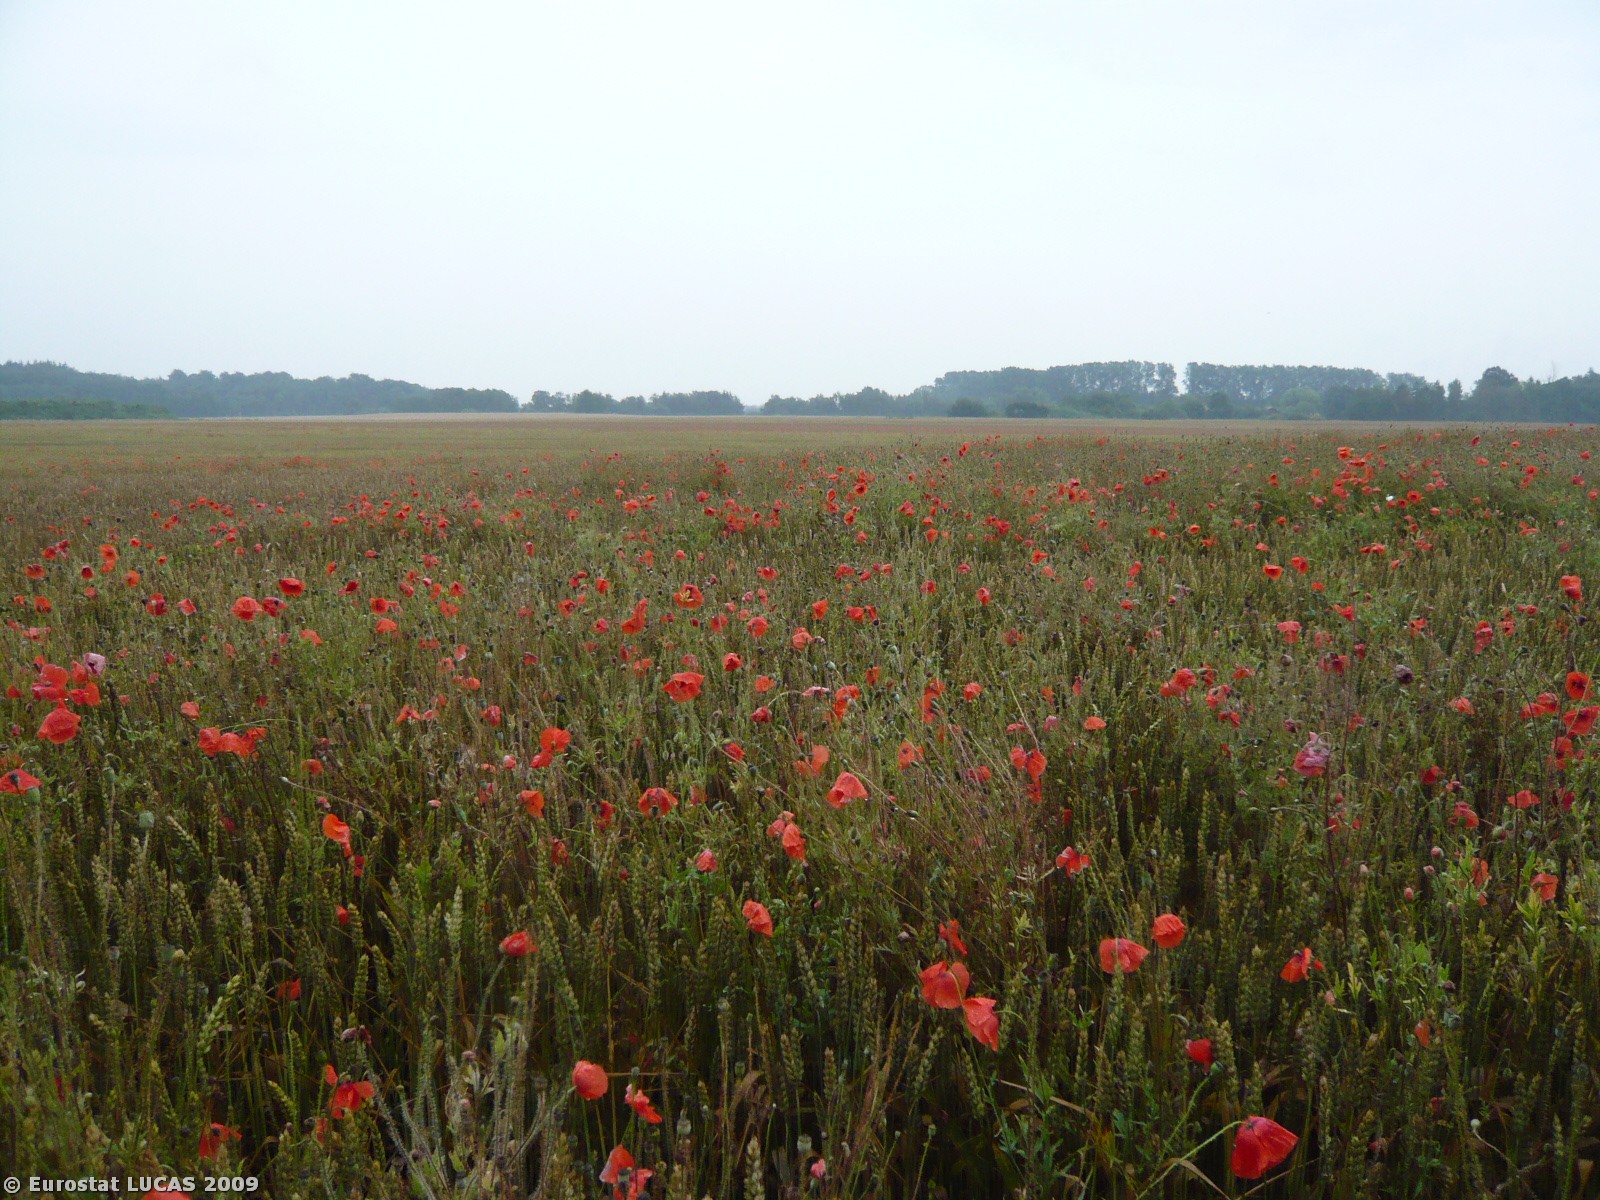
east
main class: Cropland
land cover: Common wheat
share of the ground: > 75 %
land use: Agriculture (excluding fallow land and kitchen gardens)
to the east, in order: Common wheat
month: July
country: DK
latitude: 55.5657
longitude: 11.6635
